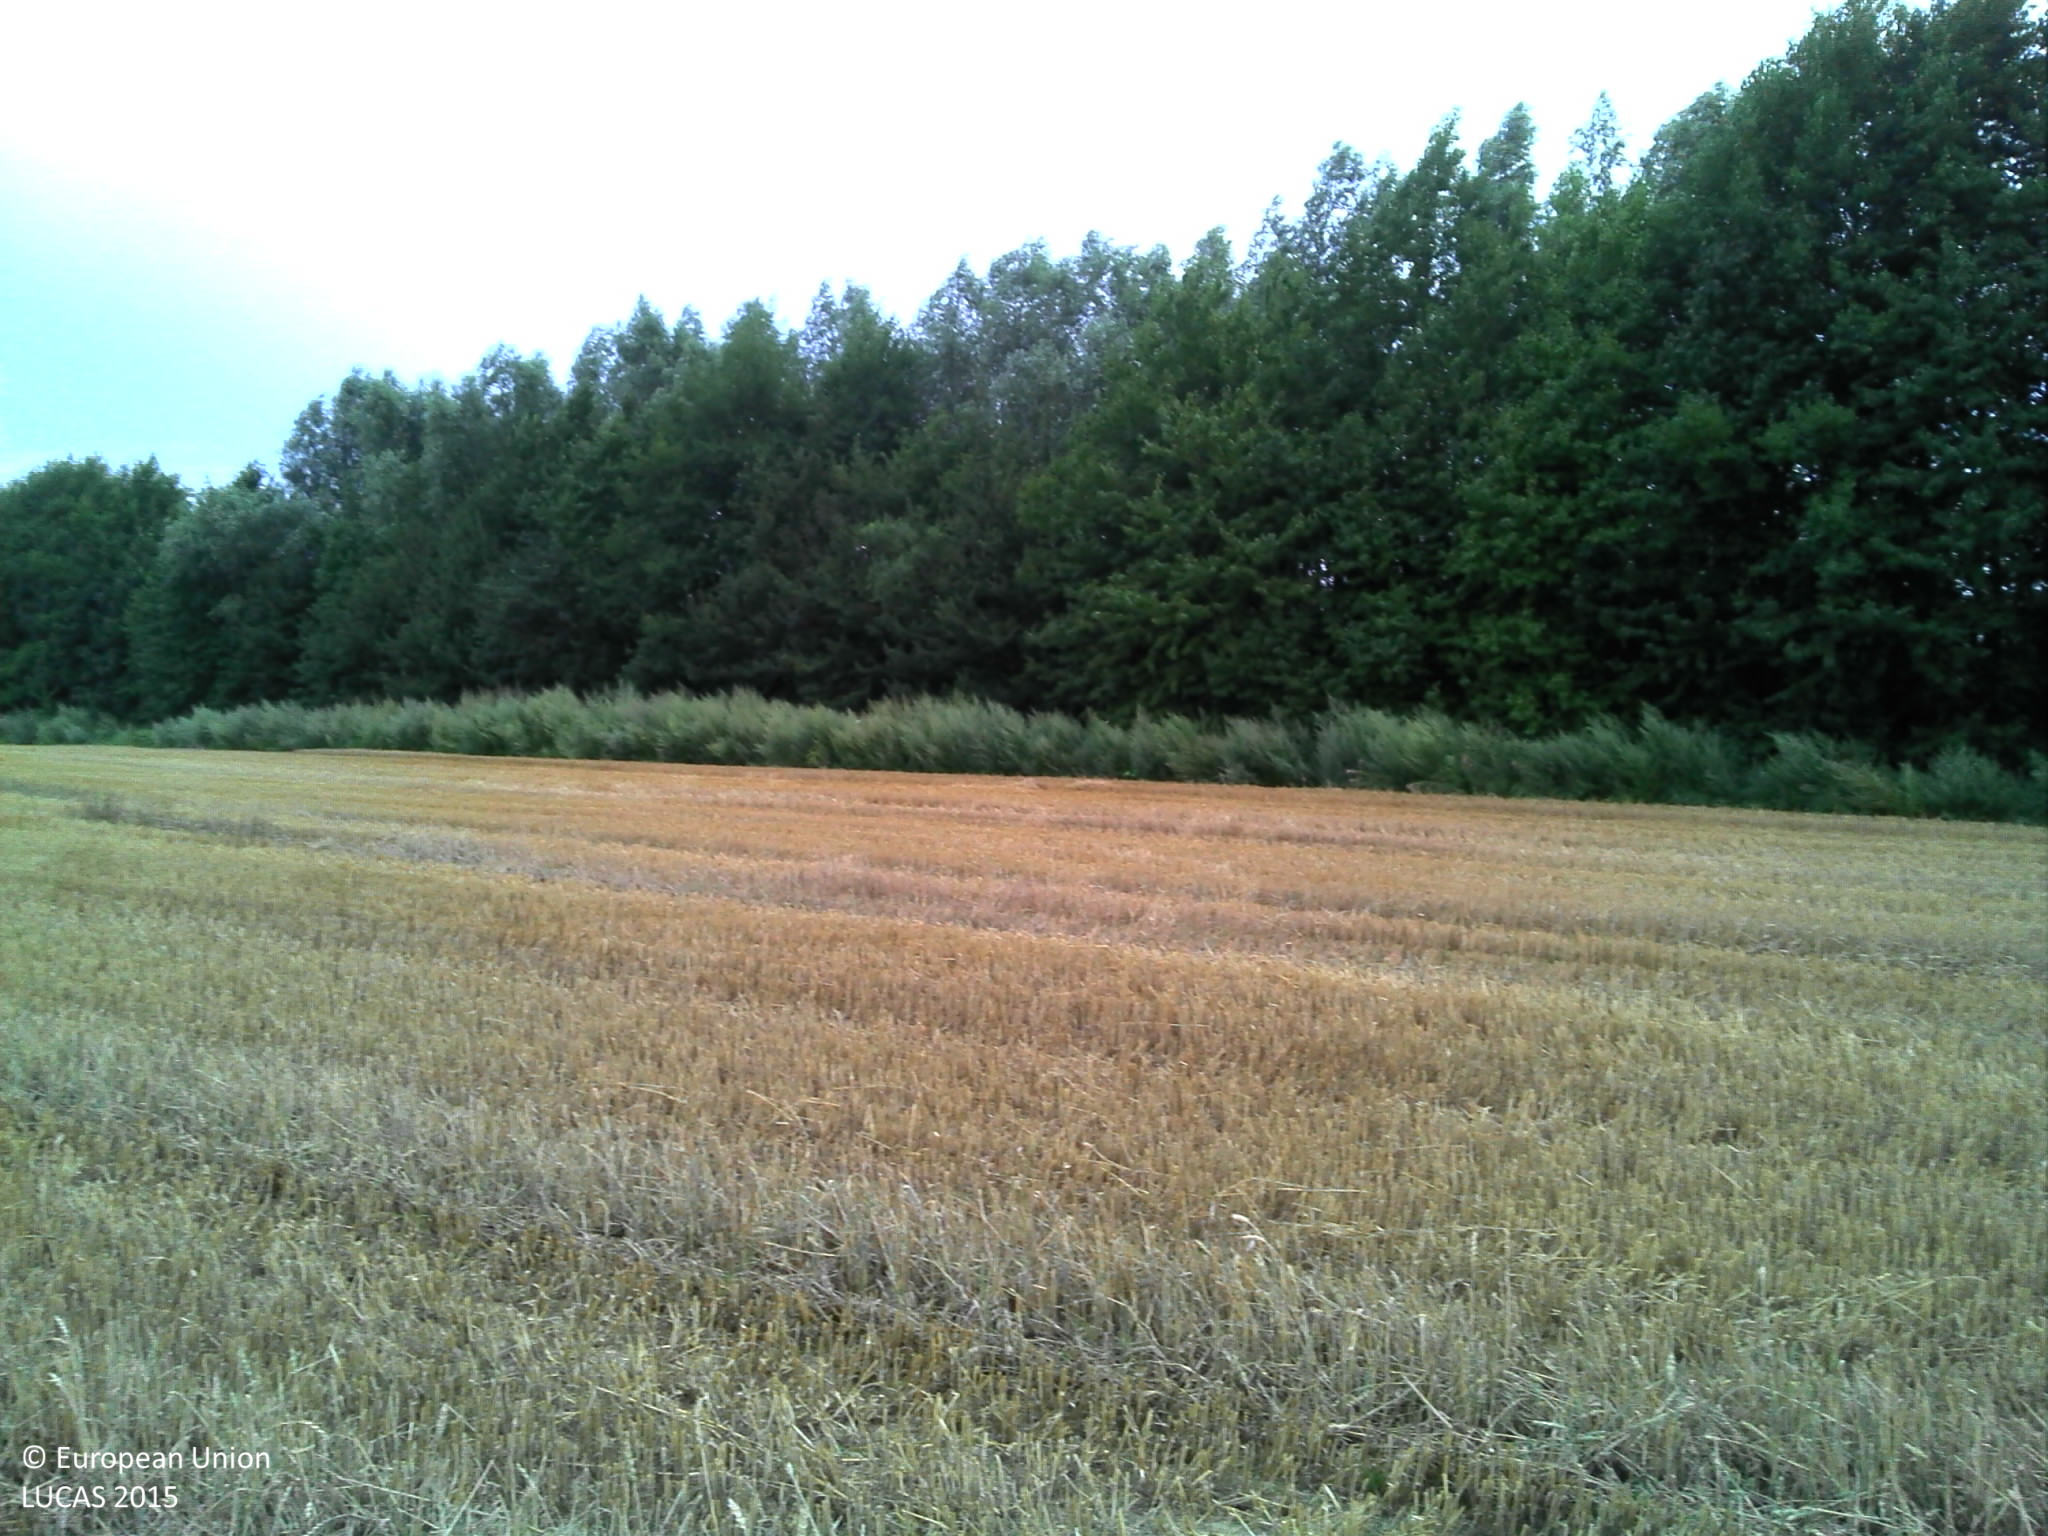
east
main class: Cropland
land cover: Common wheat
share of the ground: < 10 %
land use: Agriculture (excluding fallow land and kitchen gardens)
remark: Harvested field
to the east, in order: Common wheat; Shruby margins; Ditches and canals; Grass margins; Broadleaved woodland; Paved roads, cycling and walking lanes; Broadleaved woodland; Grassland without tree/shrub cover; Other fresh vegetables
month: August
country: BE
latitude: 50.6623
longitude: 3.7544
